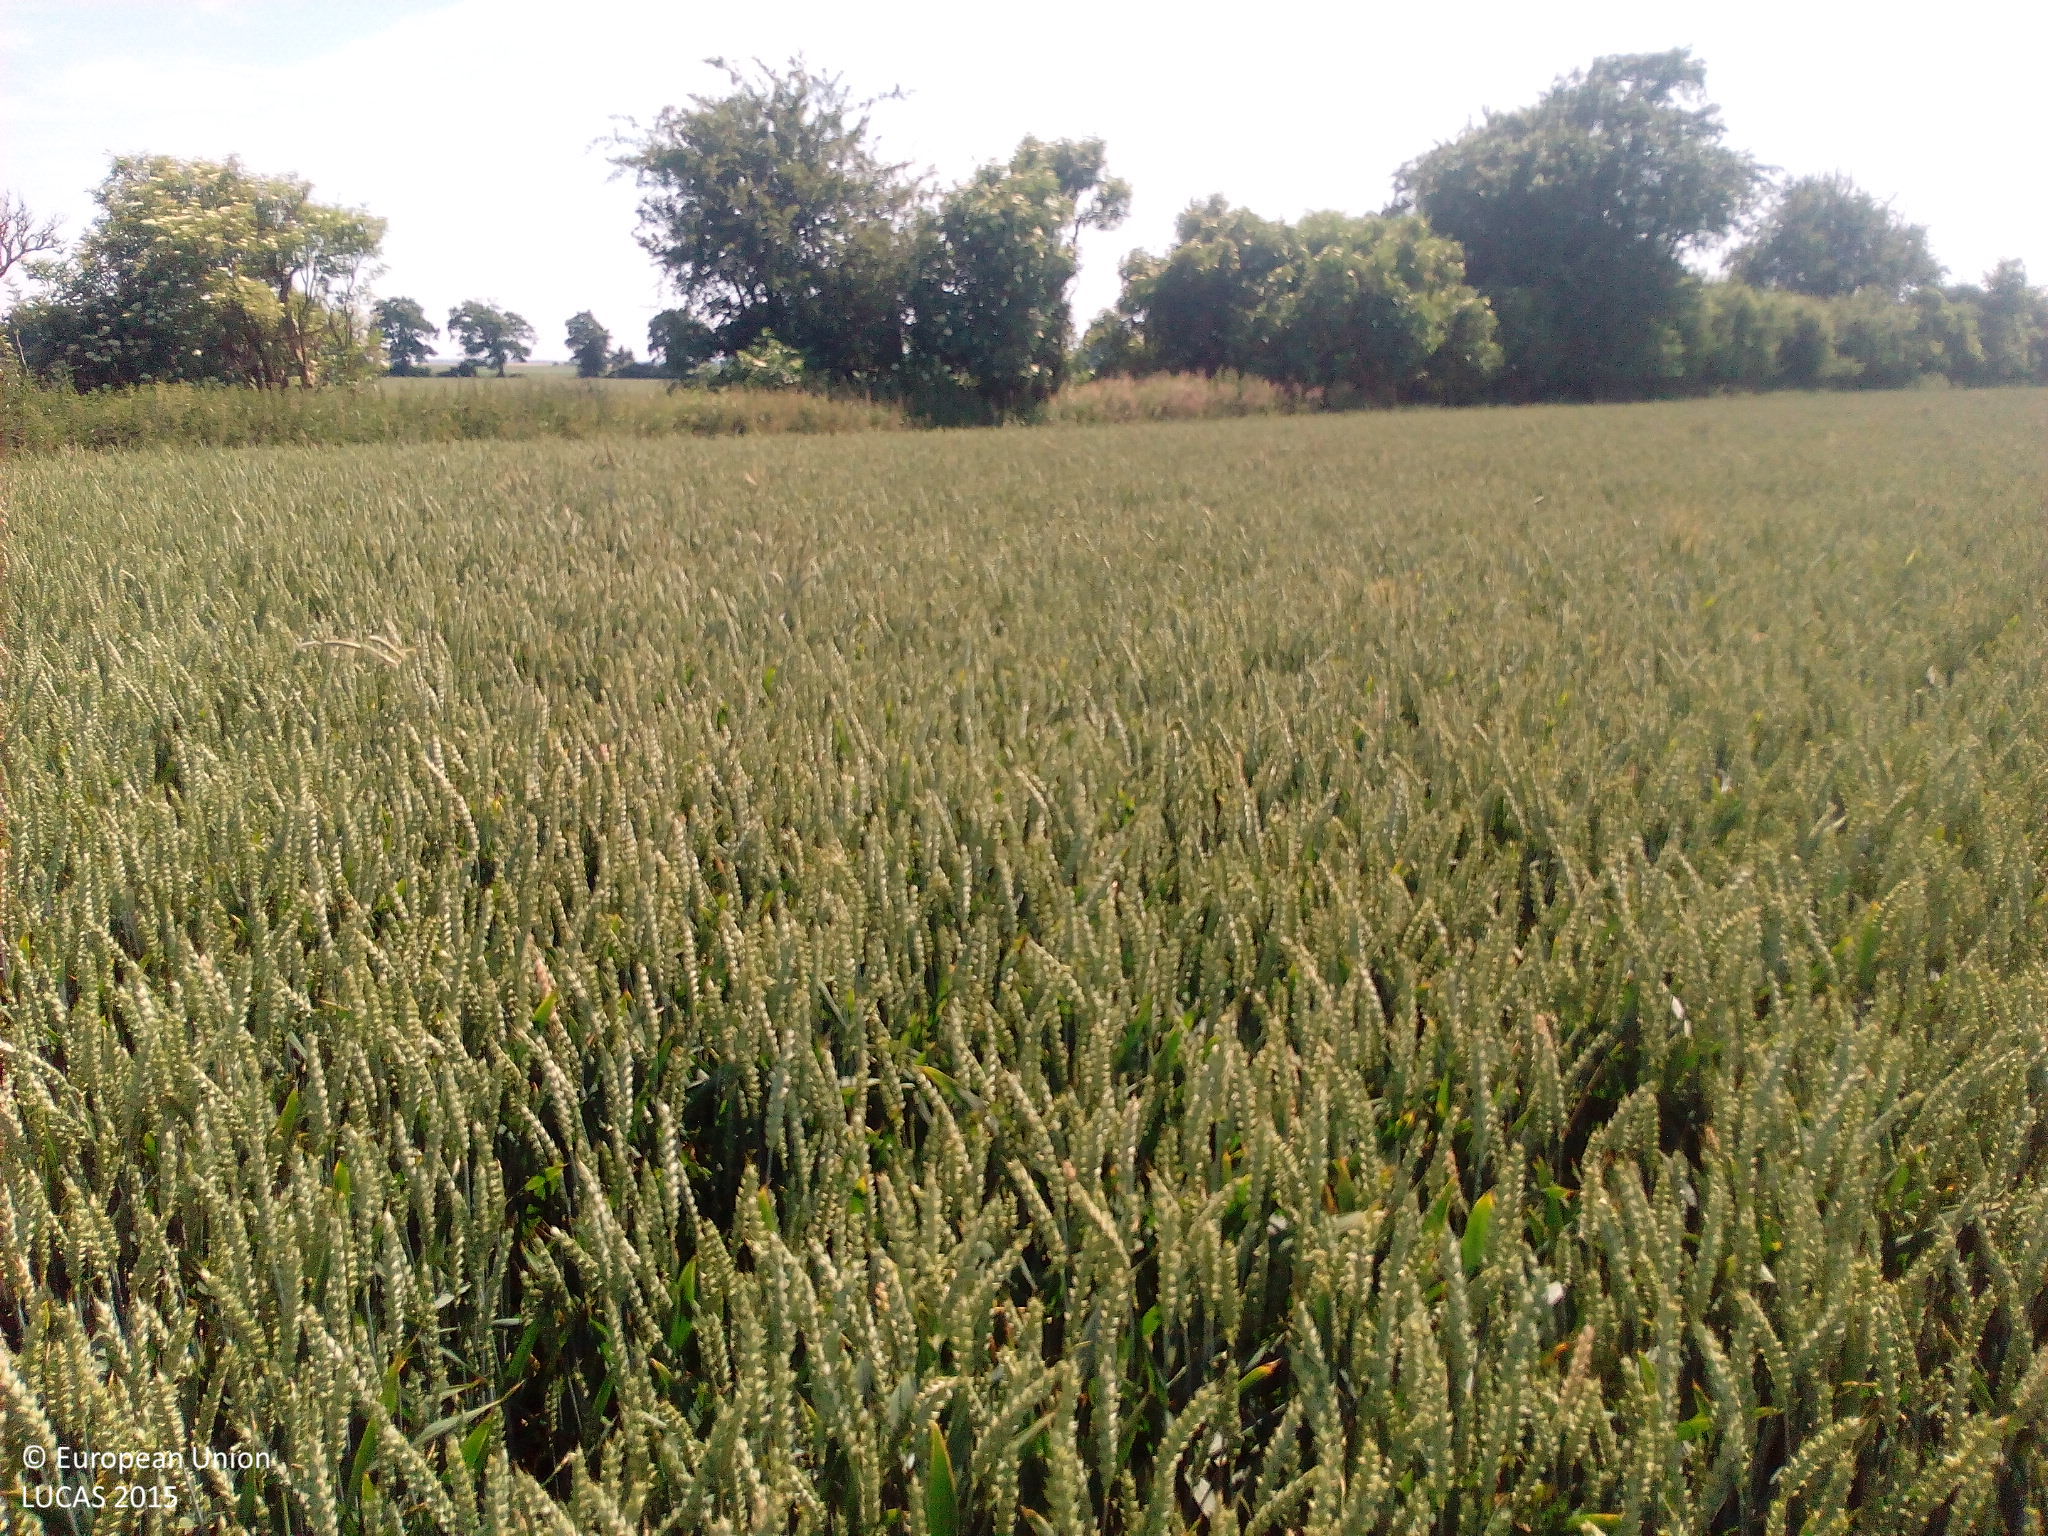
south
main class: Cropland
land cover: Common wheat
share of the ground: > 75 %
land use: Agriculture (excluding fallow land and kitchen gardens)
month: July
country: DE
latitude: 53.8795
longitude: 13.2699
